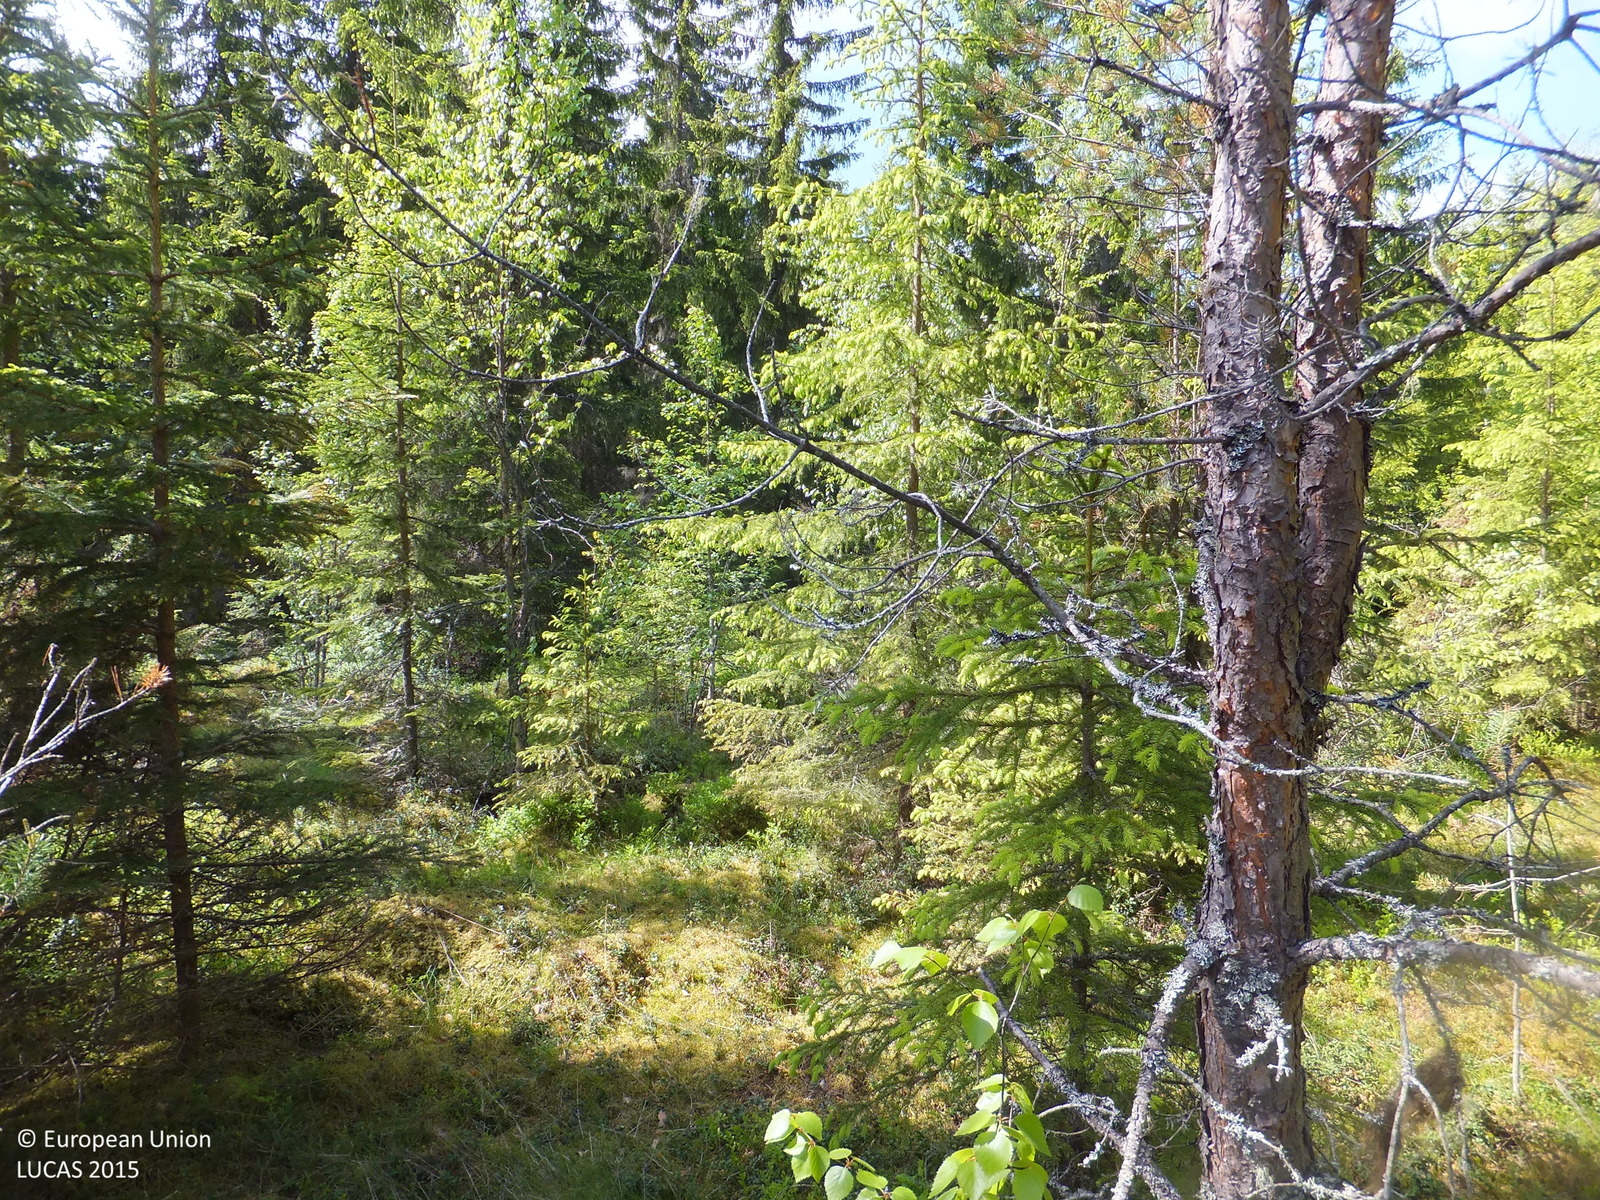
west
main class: Woodland
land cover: Pine dominated coniferous woodland
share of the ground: > 75 %
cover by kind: coniferous forest trees 80 %, broadleaved forest trees 10 %, shrubs 5 %, lichens and mosses 5 %
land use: Forestry
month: June
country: FI
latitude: 63.2928
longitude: 22.5544
